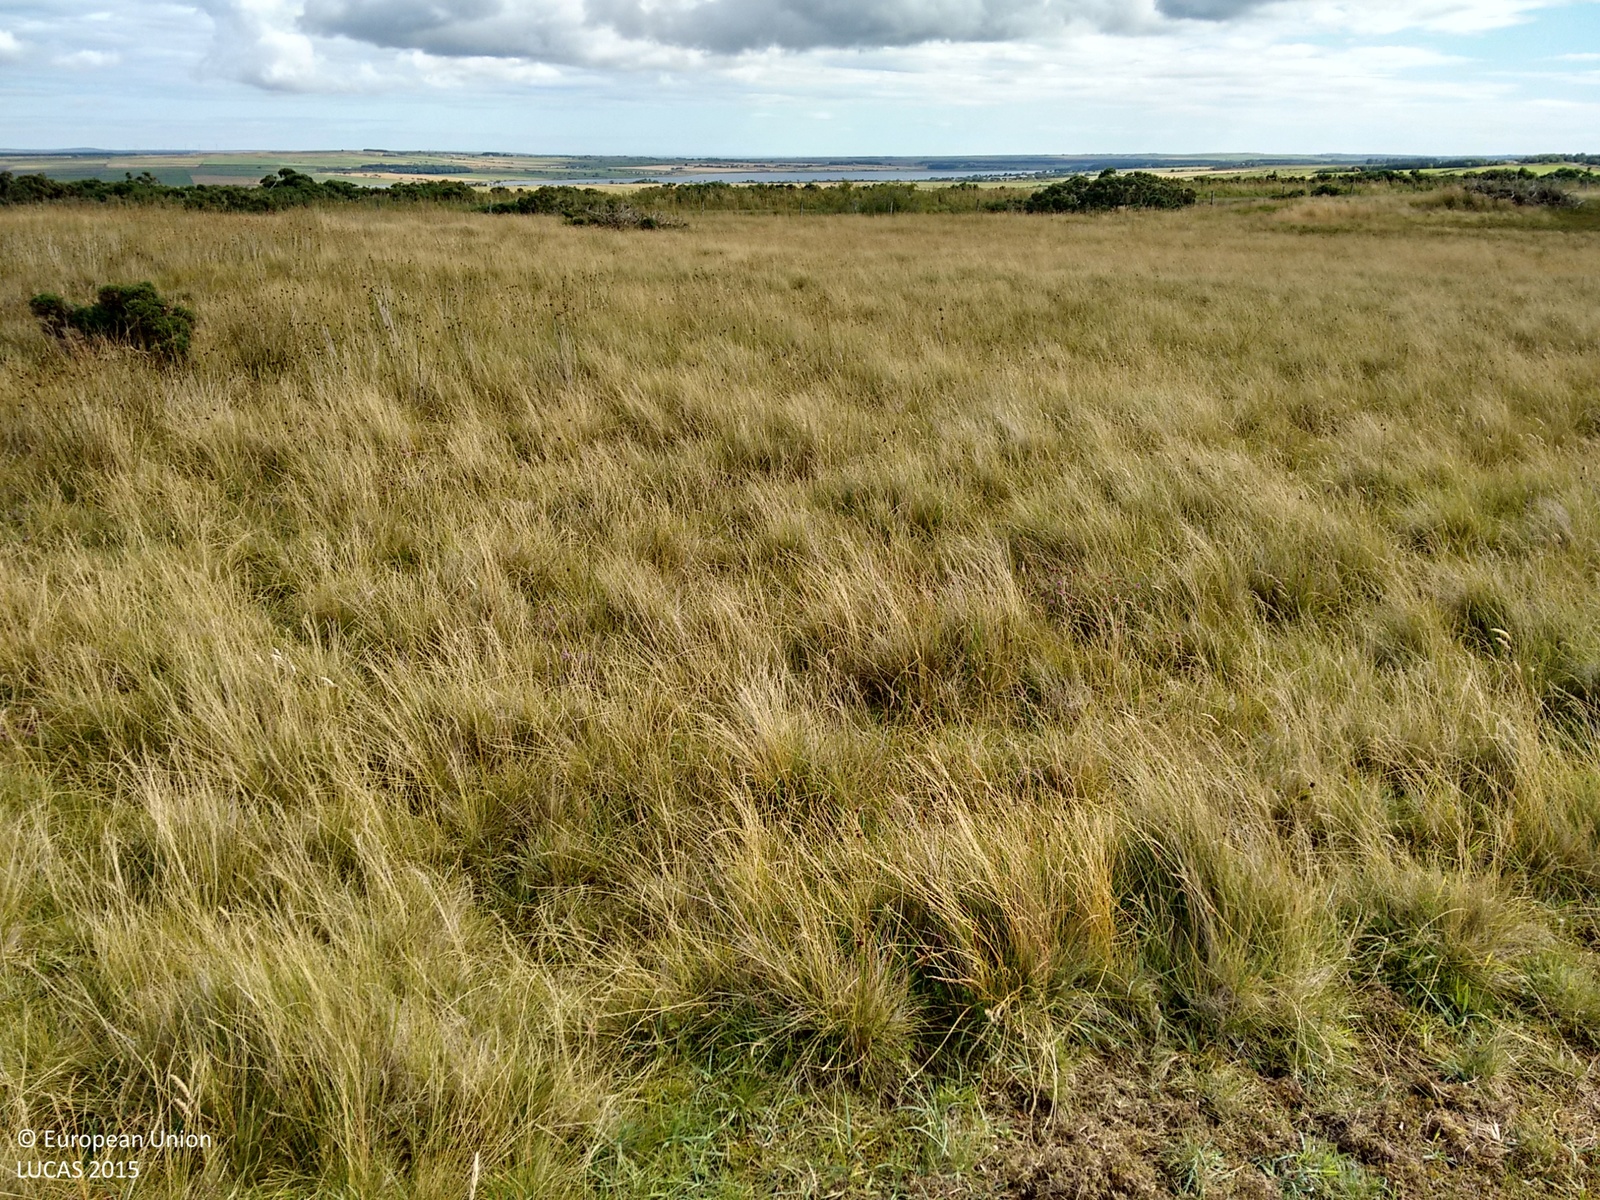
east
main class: Grassland
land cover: Grassland without tree/shrub cover
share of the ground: > 75 %
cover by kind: herbaceous plants 95 %, shrubs 5 %
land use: Agriculture (excluding fallow land and kitchen gardens)
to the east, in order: Grassland without tree/shrub cover; Grassland with sparse tree/shrub cover; Fences; Shruby margins; Grass margins; Paved roads, cycling and walking lanes; Grass margins; Ditches and canals; Shruby margins; Fences; Grassland without tree/shrub cover; Fences; Shruby margins; Grass margins; Tracks
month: August
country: GB
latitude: 58.4778
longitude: -3.3870
